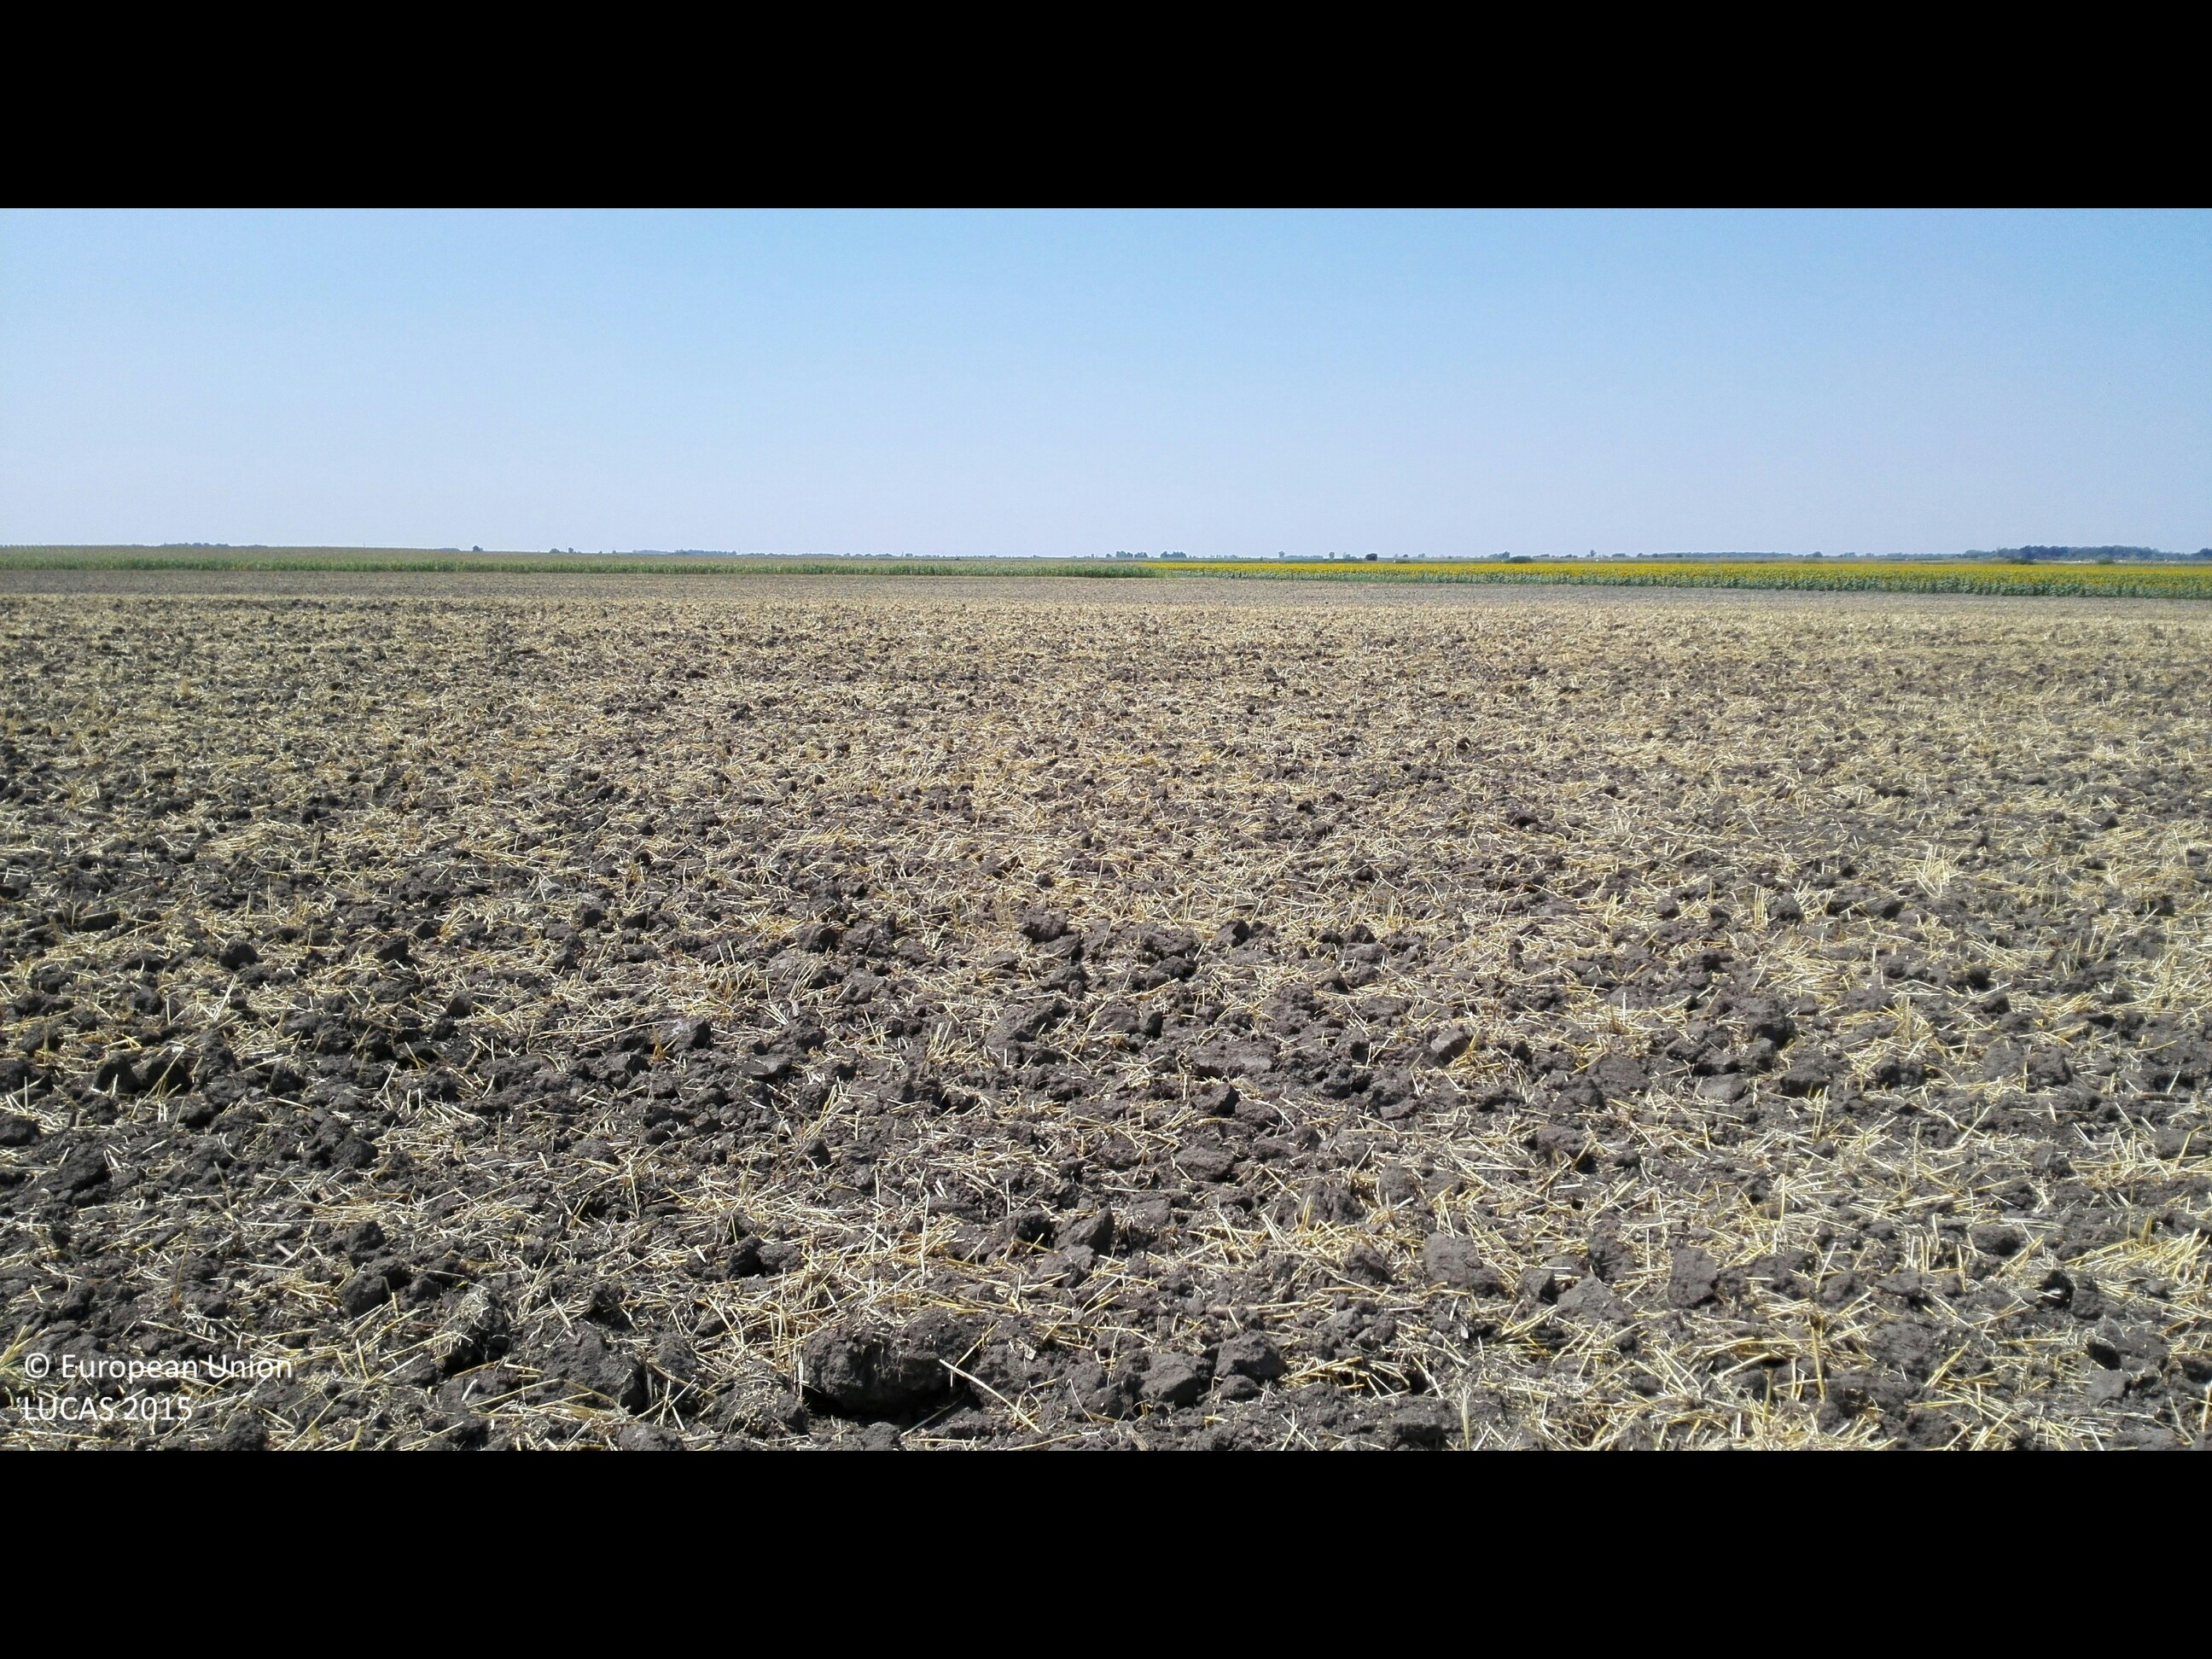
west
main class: Cropland
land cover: Barley
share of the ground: < 10 %
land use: Agriculture (excluding fallow land and kitchen gardens)
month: July
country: HU
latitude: 47.2400
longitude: 21.3075
